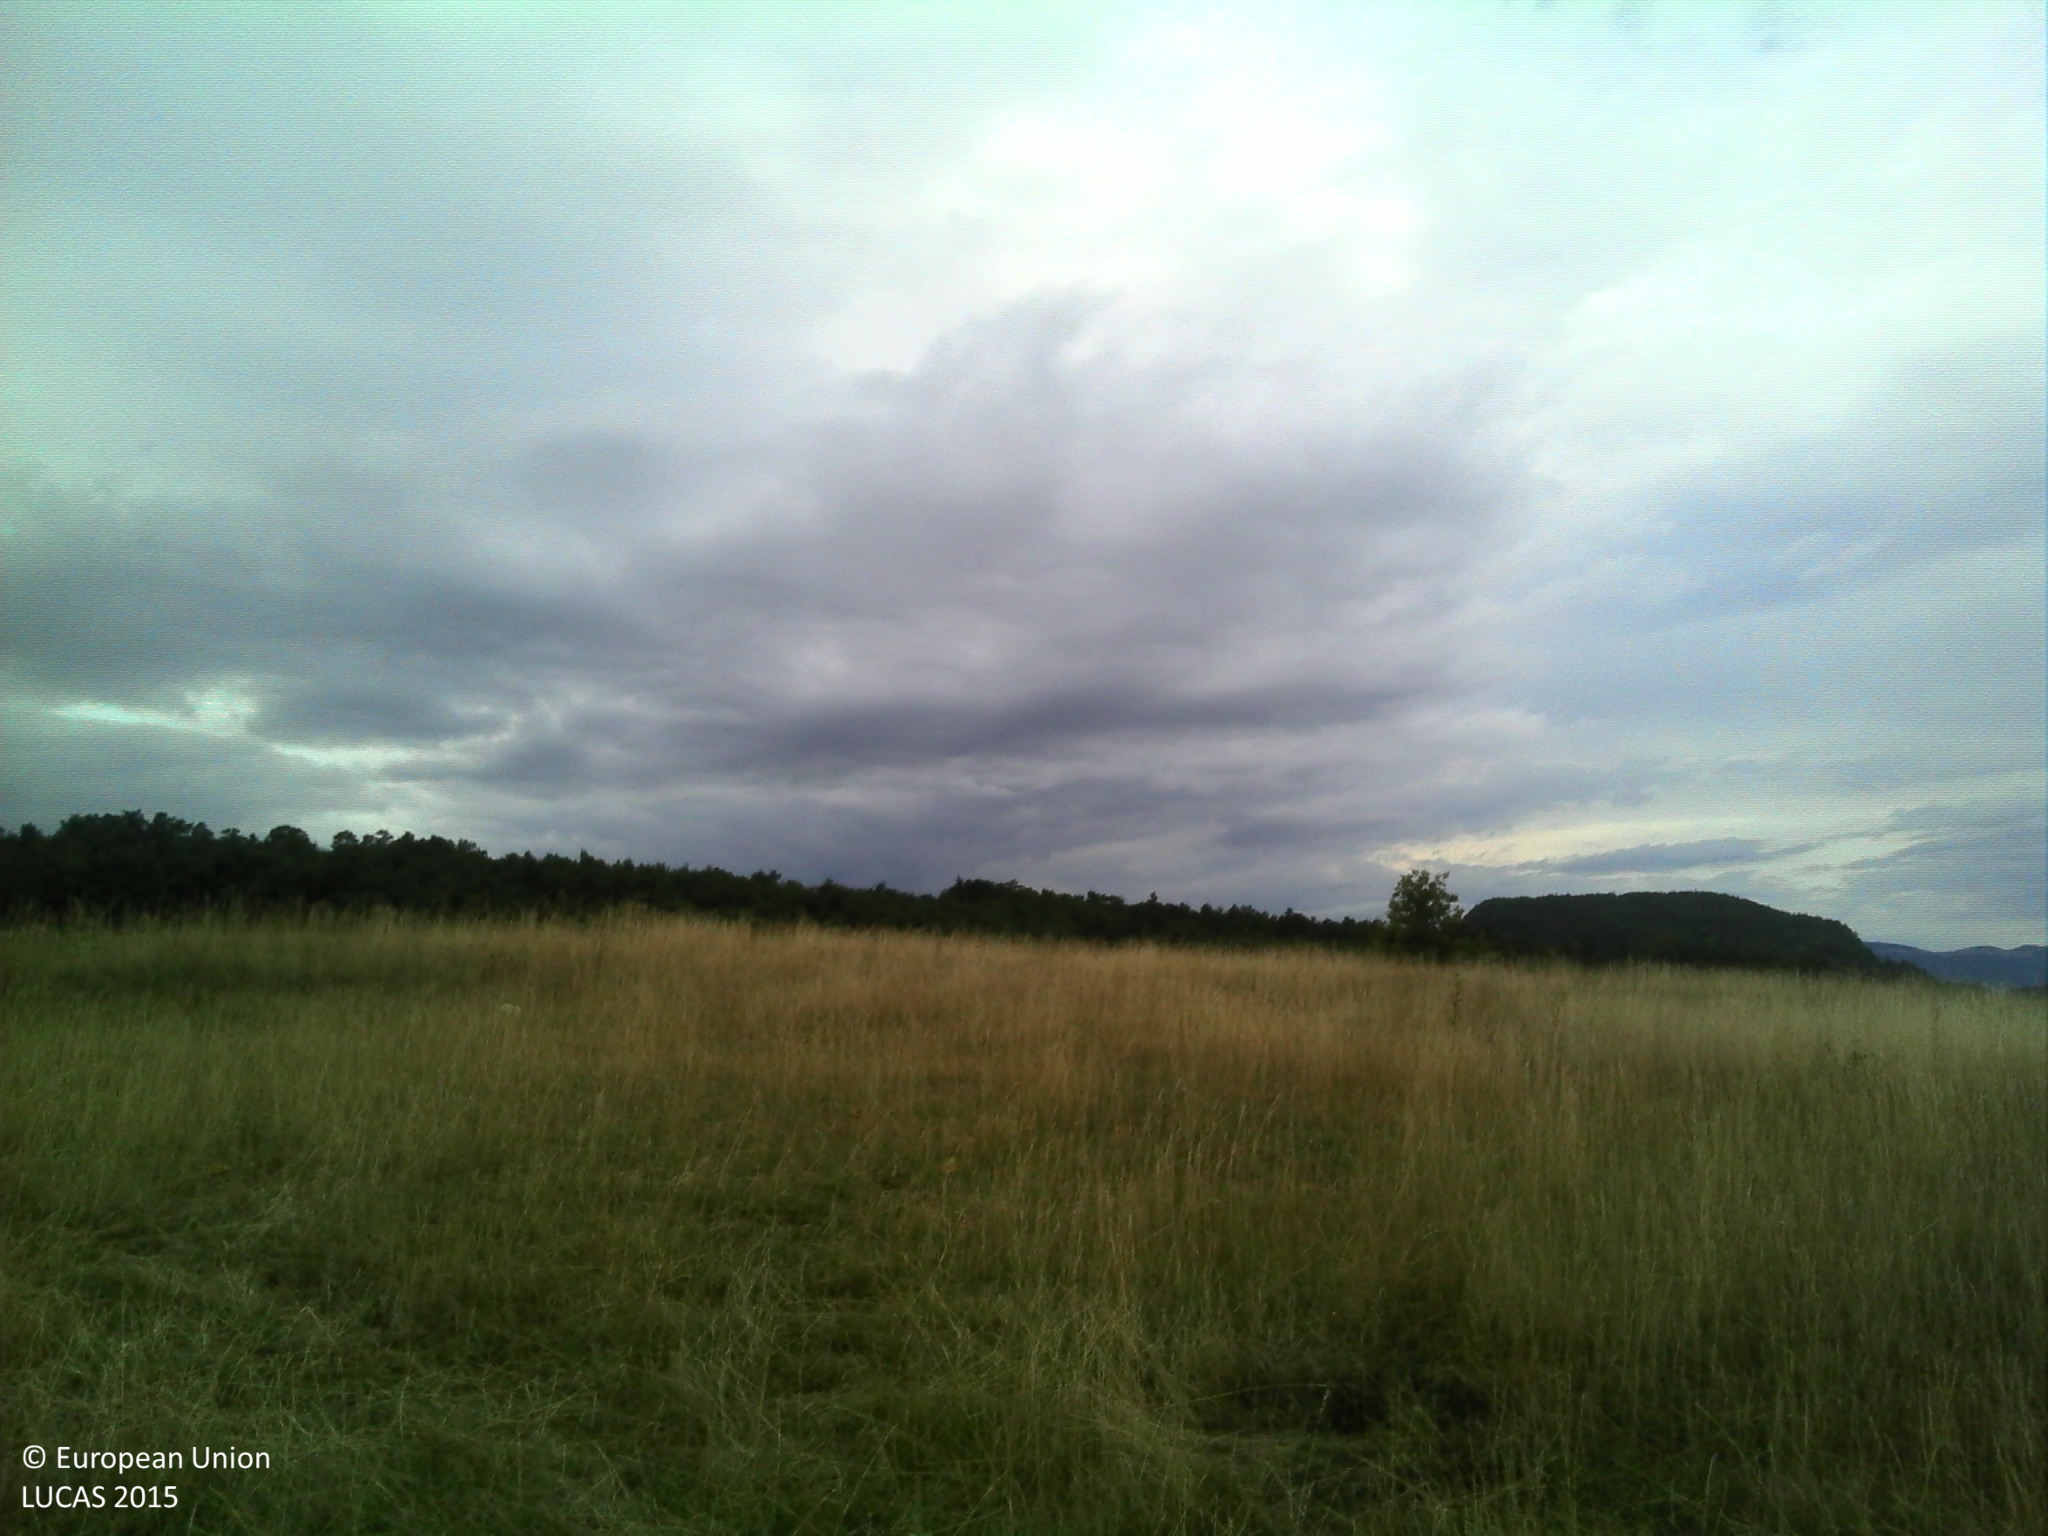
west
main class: Grassland
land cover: Grassland without tree/shrub cover
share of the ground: > 75 %
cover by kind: herbaceous plants 100 %
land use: Agriculture (excluding fallow land and kitchen gardens)
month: September
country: FR
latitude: 44.5796
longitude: 5.5359
